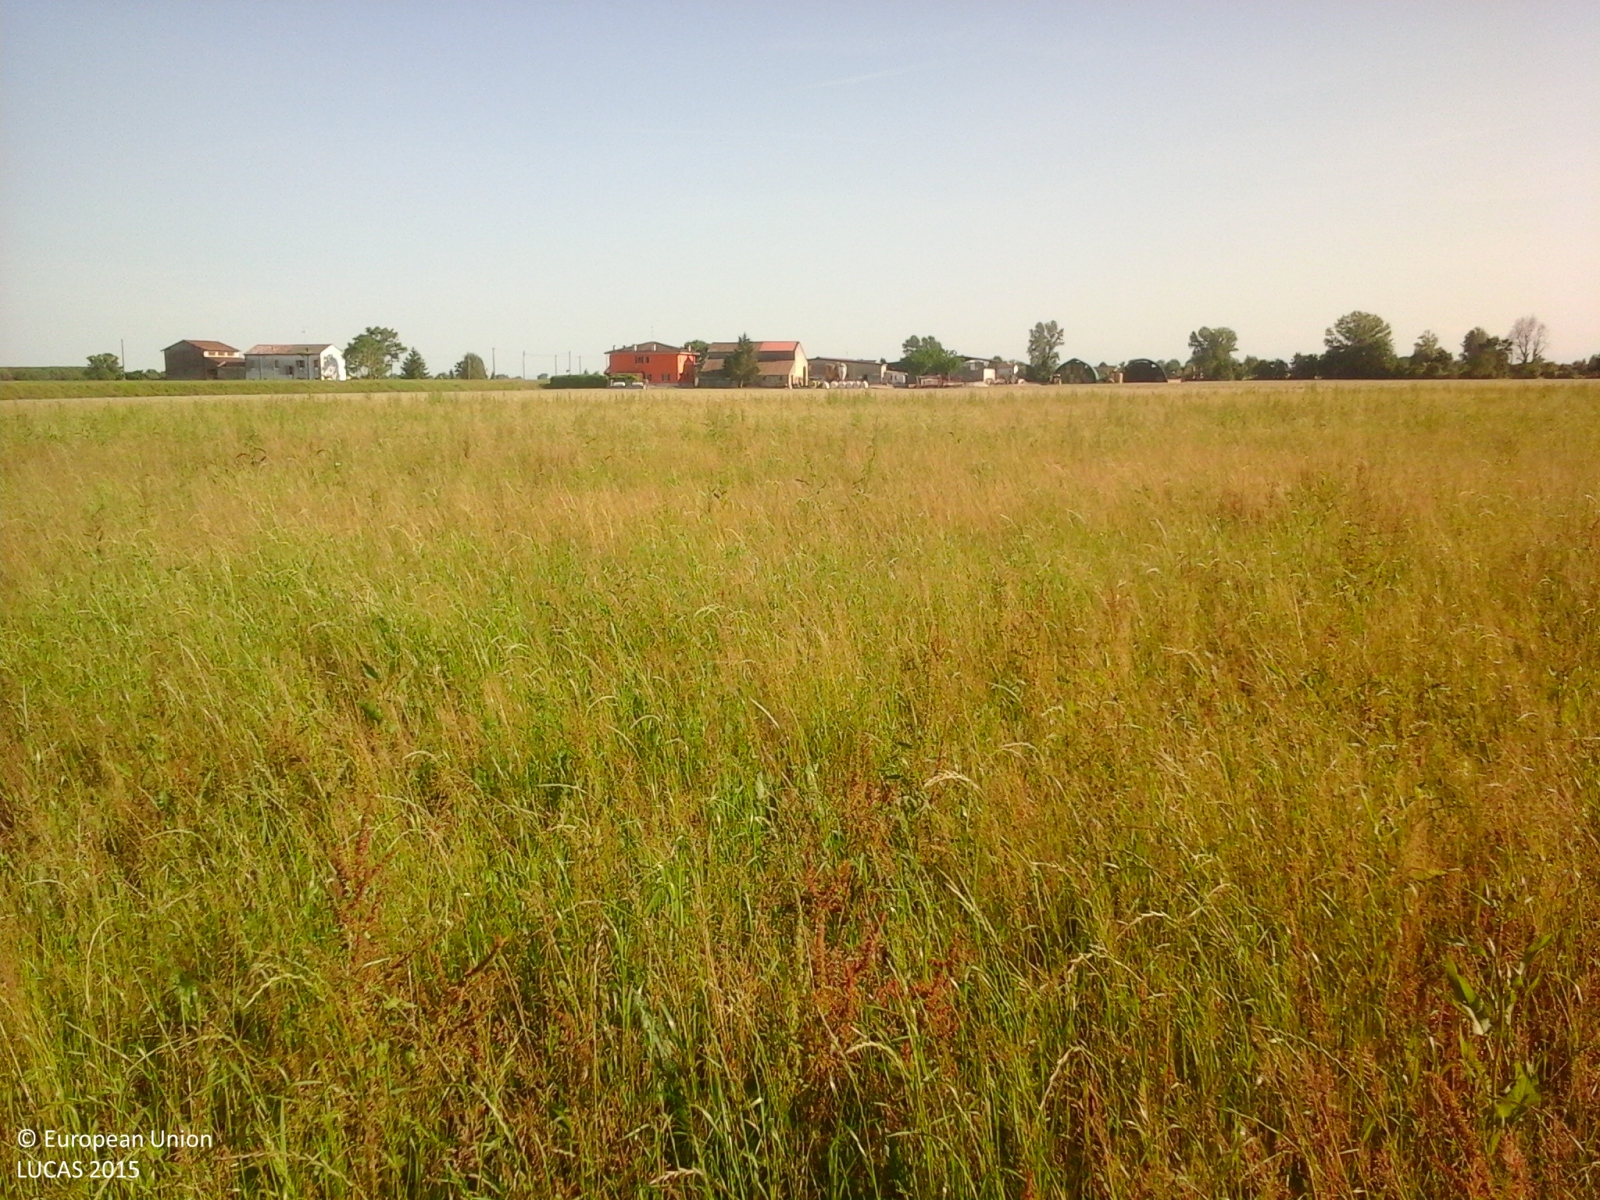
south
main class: Cropland
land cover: Temporary grasslands
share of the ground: > 75 %
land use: Agriculture (excluding fallow land and kitchen gardens)
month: May
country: IT
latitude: 44.9776
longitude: 10.9239
